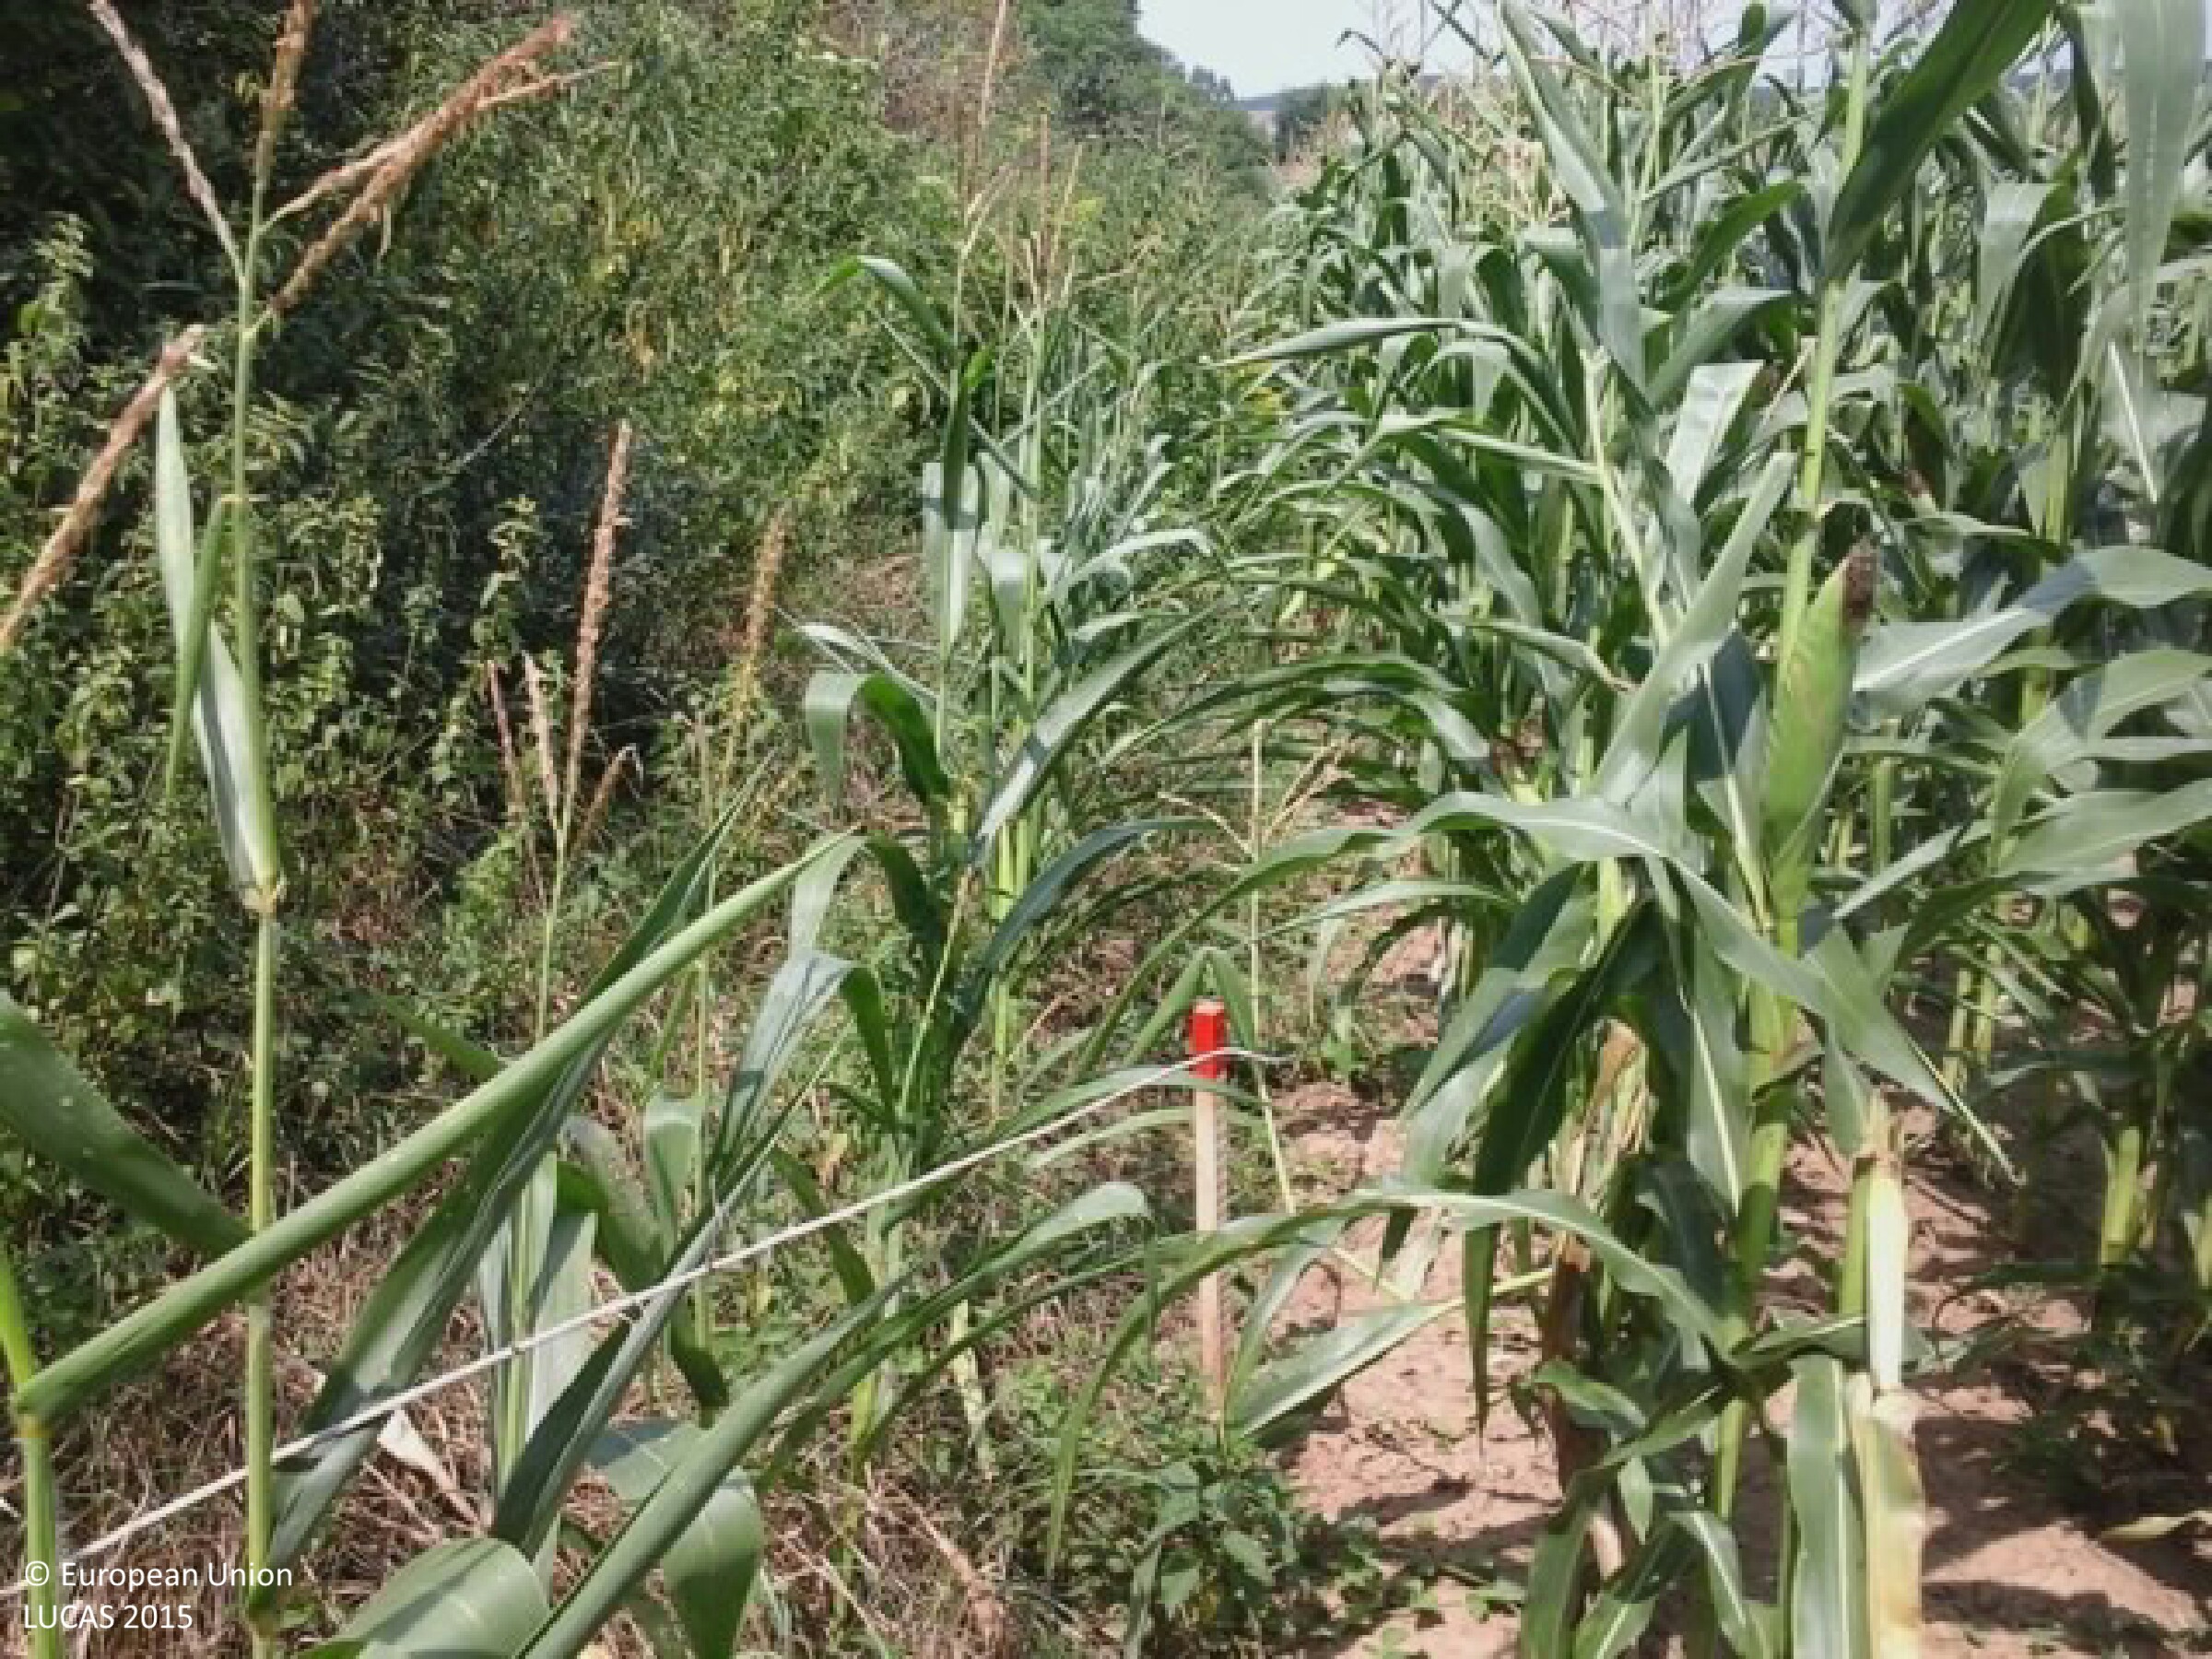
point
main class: Cropland
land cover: Maize
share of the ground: > 75 %
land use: Agriculture (excluding fallow land and kitchen gardens)
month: August
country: HU
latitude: 46.5767
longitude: 17.7442
